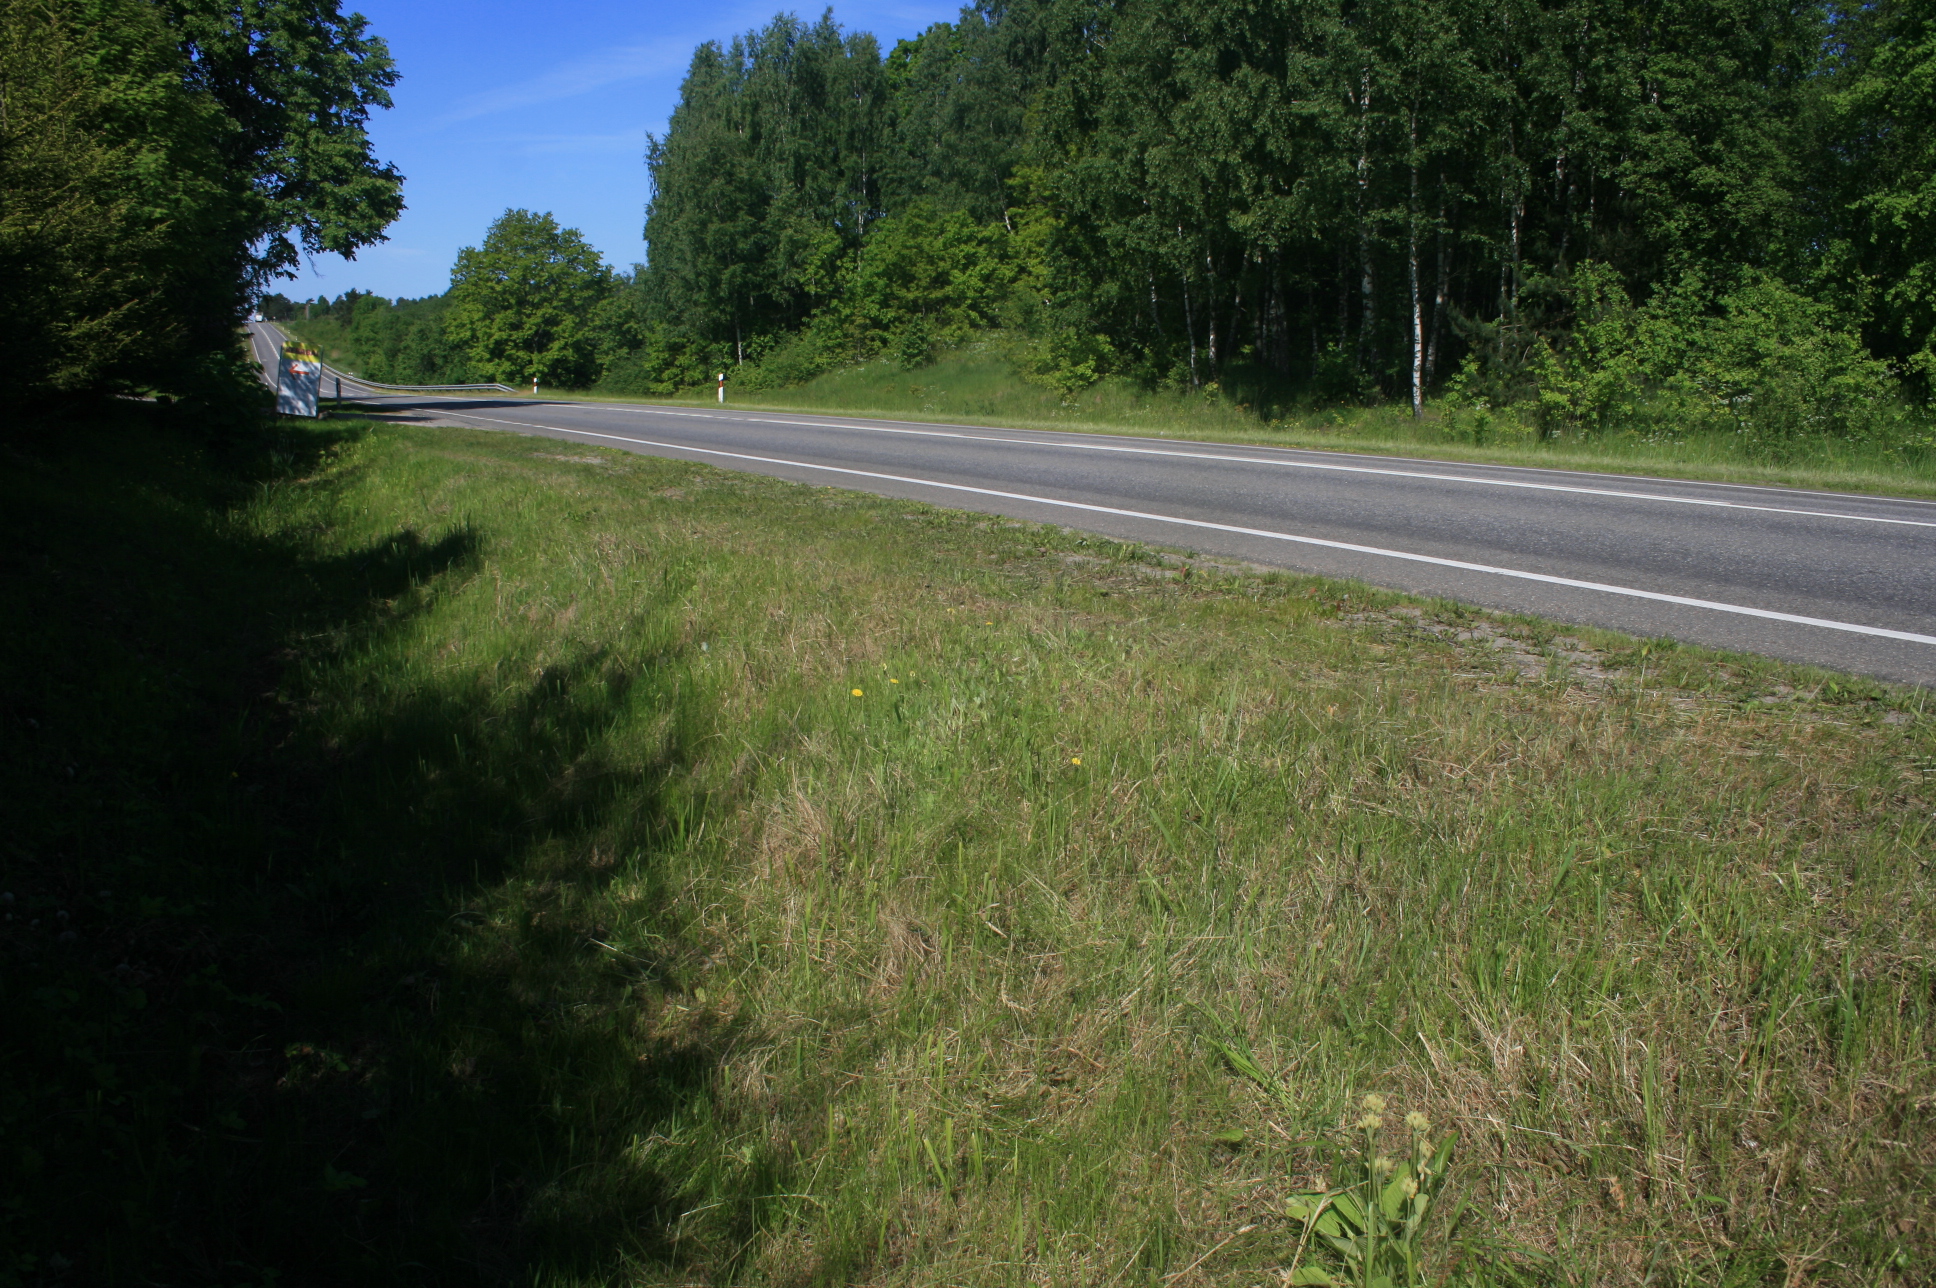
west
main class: Grassland
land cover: Grassland without tree/shrub cover
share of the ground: > 75 %
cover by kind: herbaceous plants 100 %
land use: Road transport
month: June
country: LT
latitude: 55.9217
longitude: 21.5183
